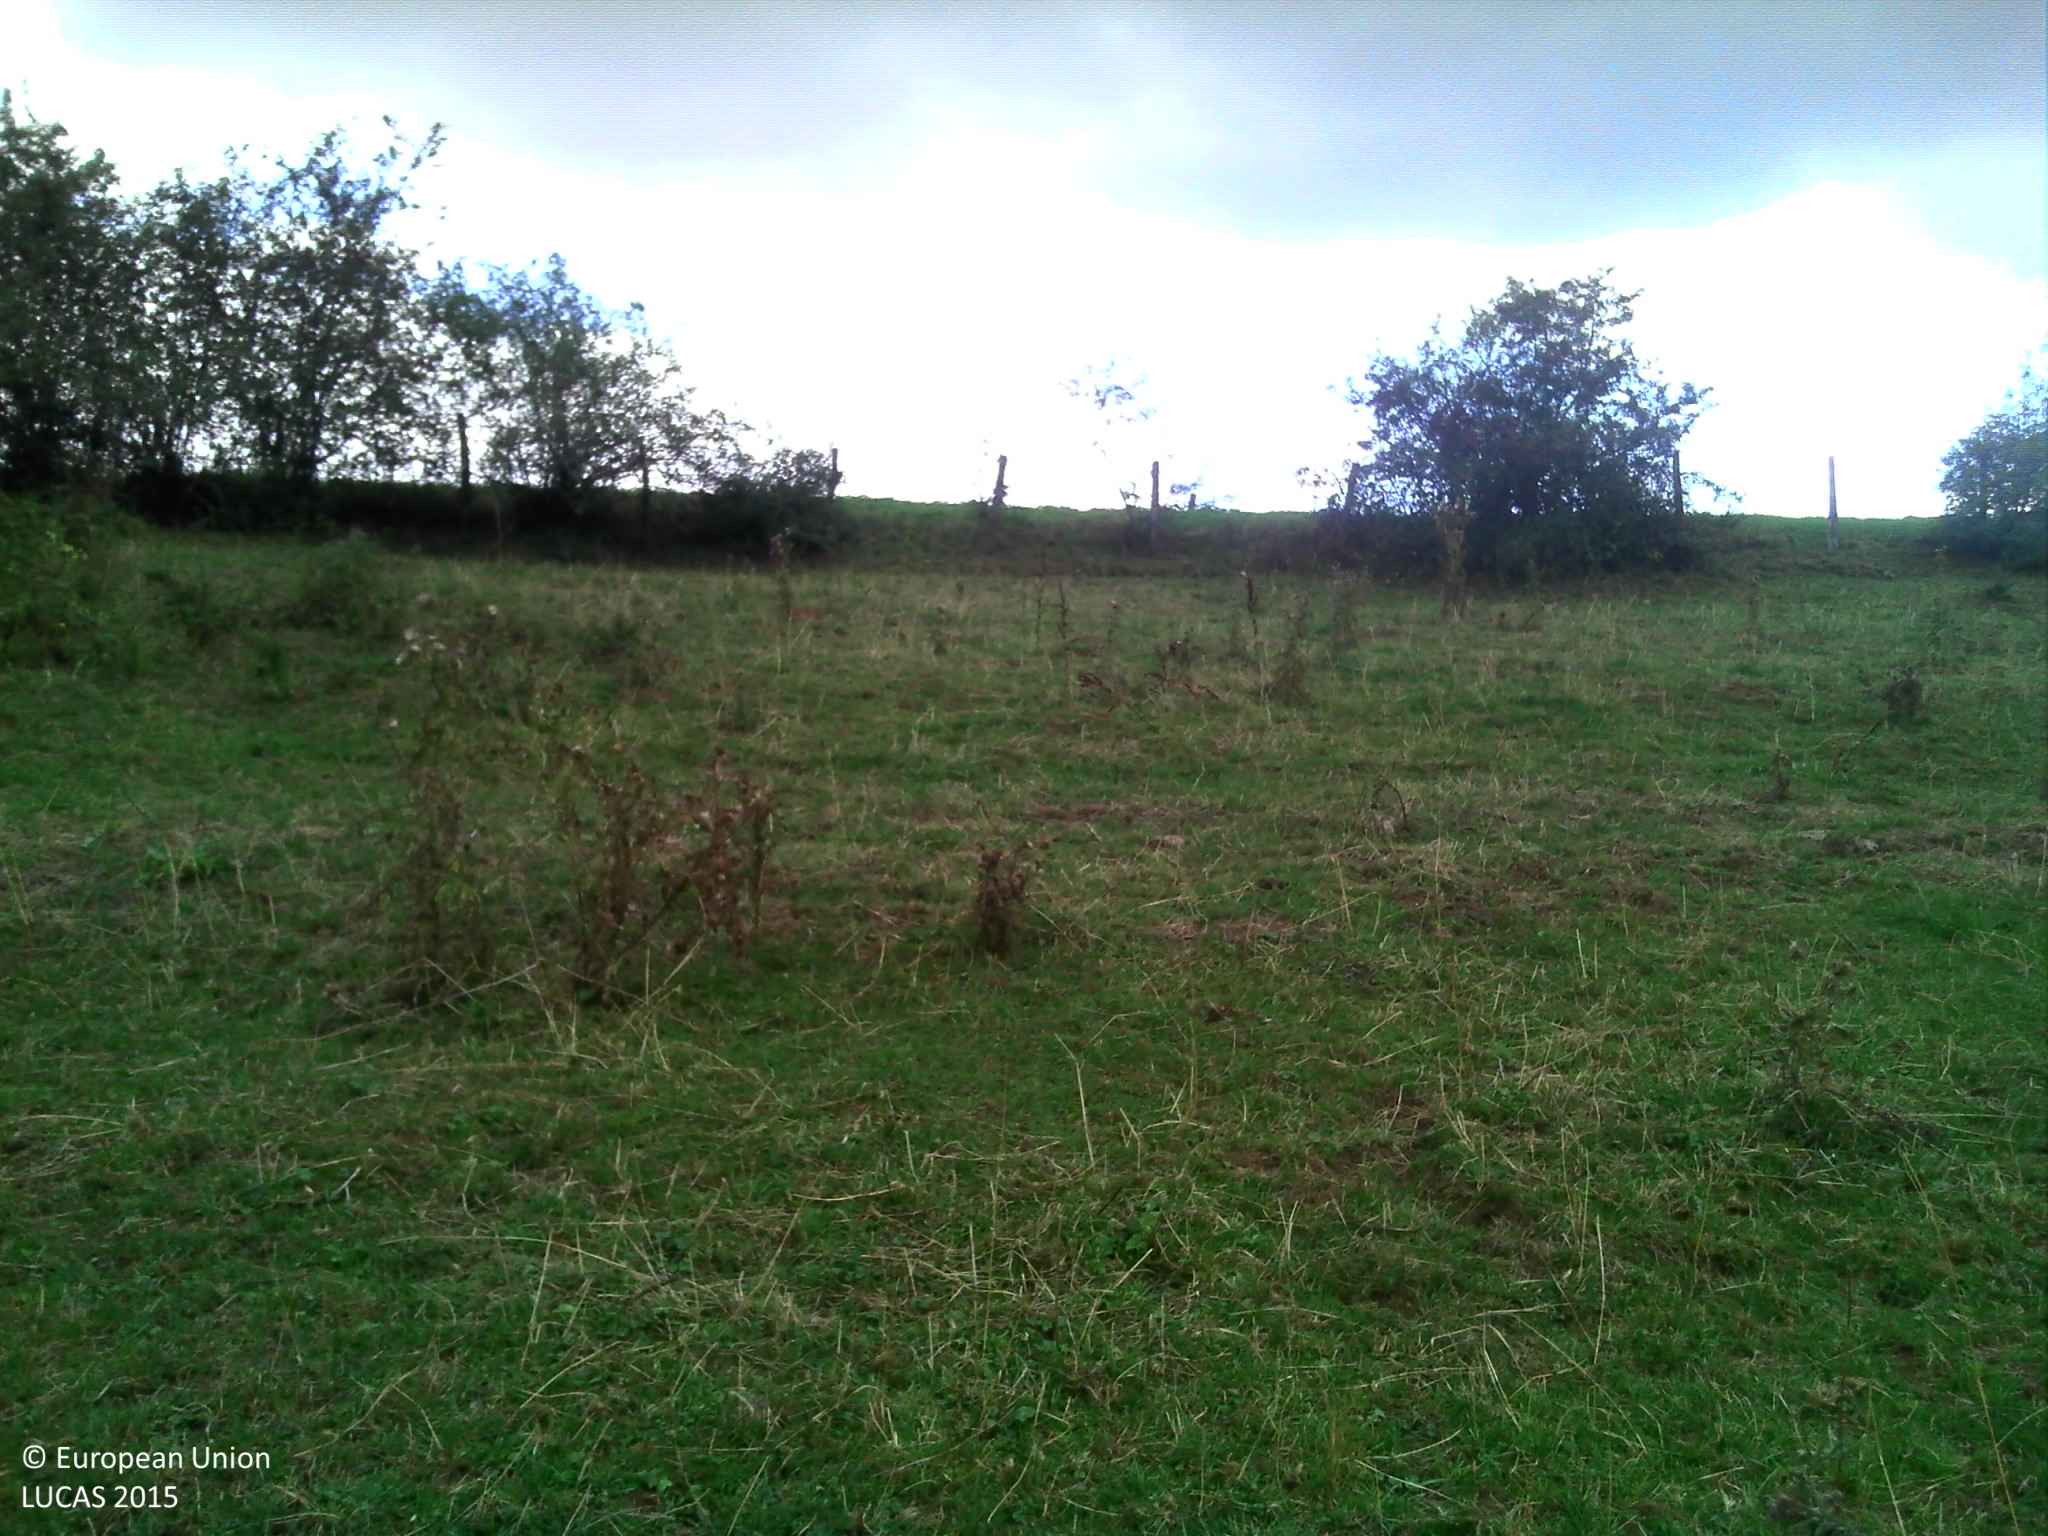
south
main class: Grassland
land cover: Grassland without tree/shrub cover
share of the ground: > 75 %
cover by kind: herbaceous plants 100 %
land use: Agriculture (excluding fallow land and kitchen gardens)
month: August
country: FR
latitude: 47.3228
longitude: 4.7473
